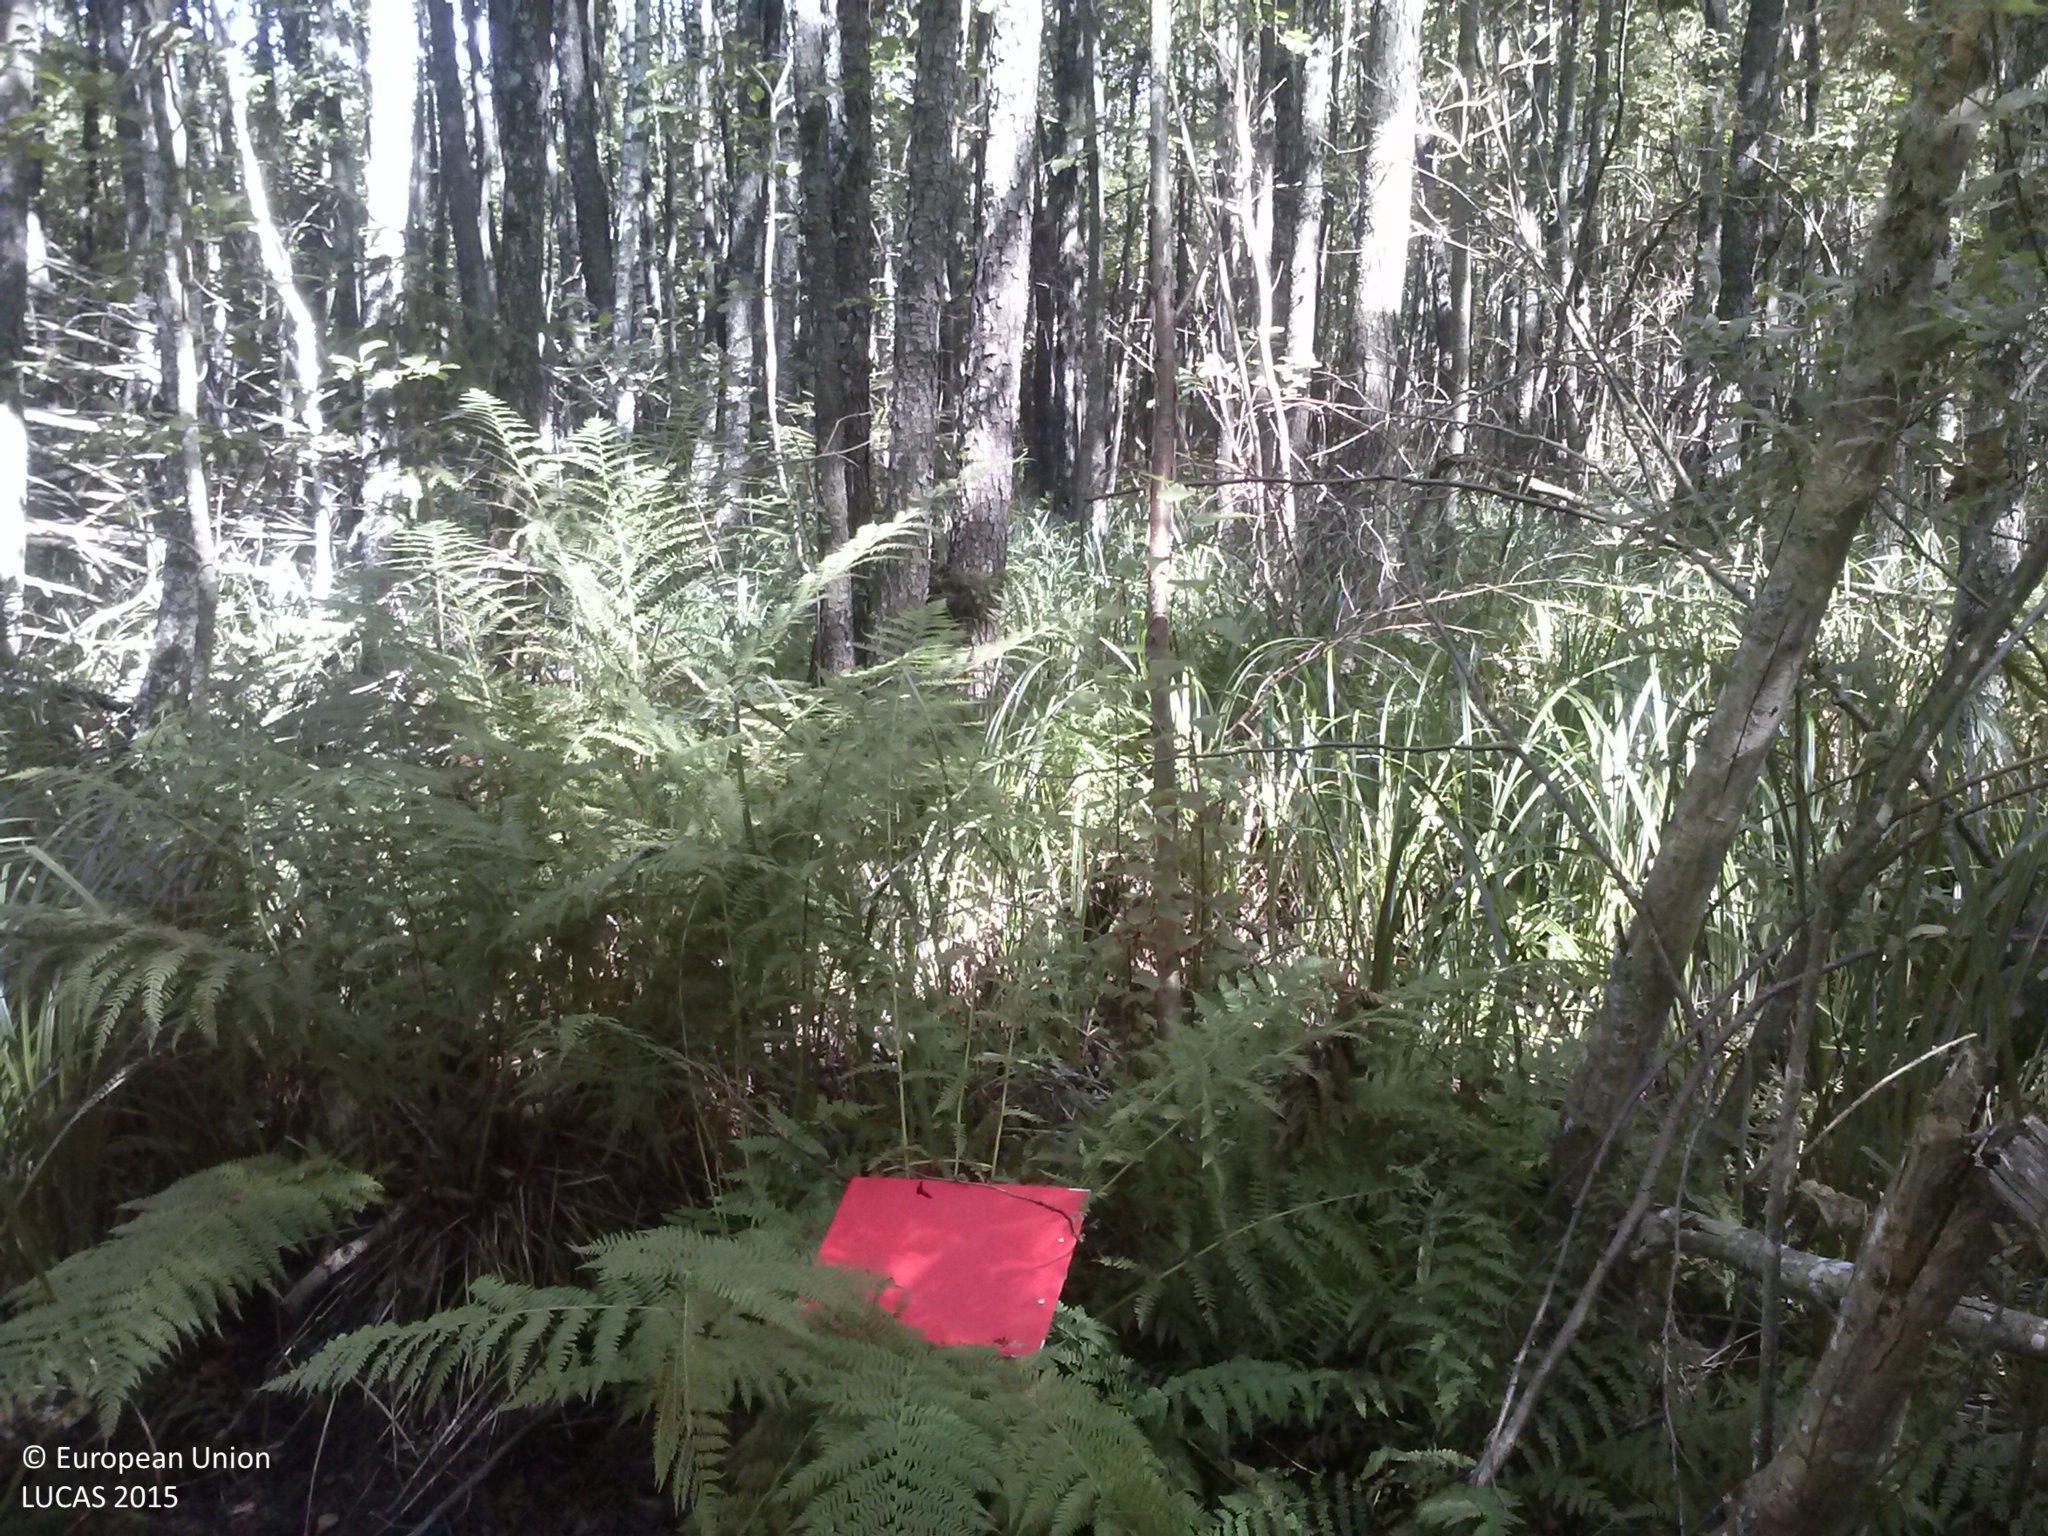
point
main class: Woodland
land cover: Broadleaved woodland
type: non-riverine alder, birch or aspen forest
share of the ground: > 75 %
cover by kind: broadleaved forest trees 75 %, herbaceous plants 25 %
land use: Forestry
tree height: > 5 m
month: August
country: LV
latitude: 56.1998
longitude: 26.8751
